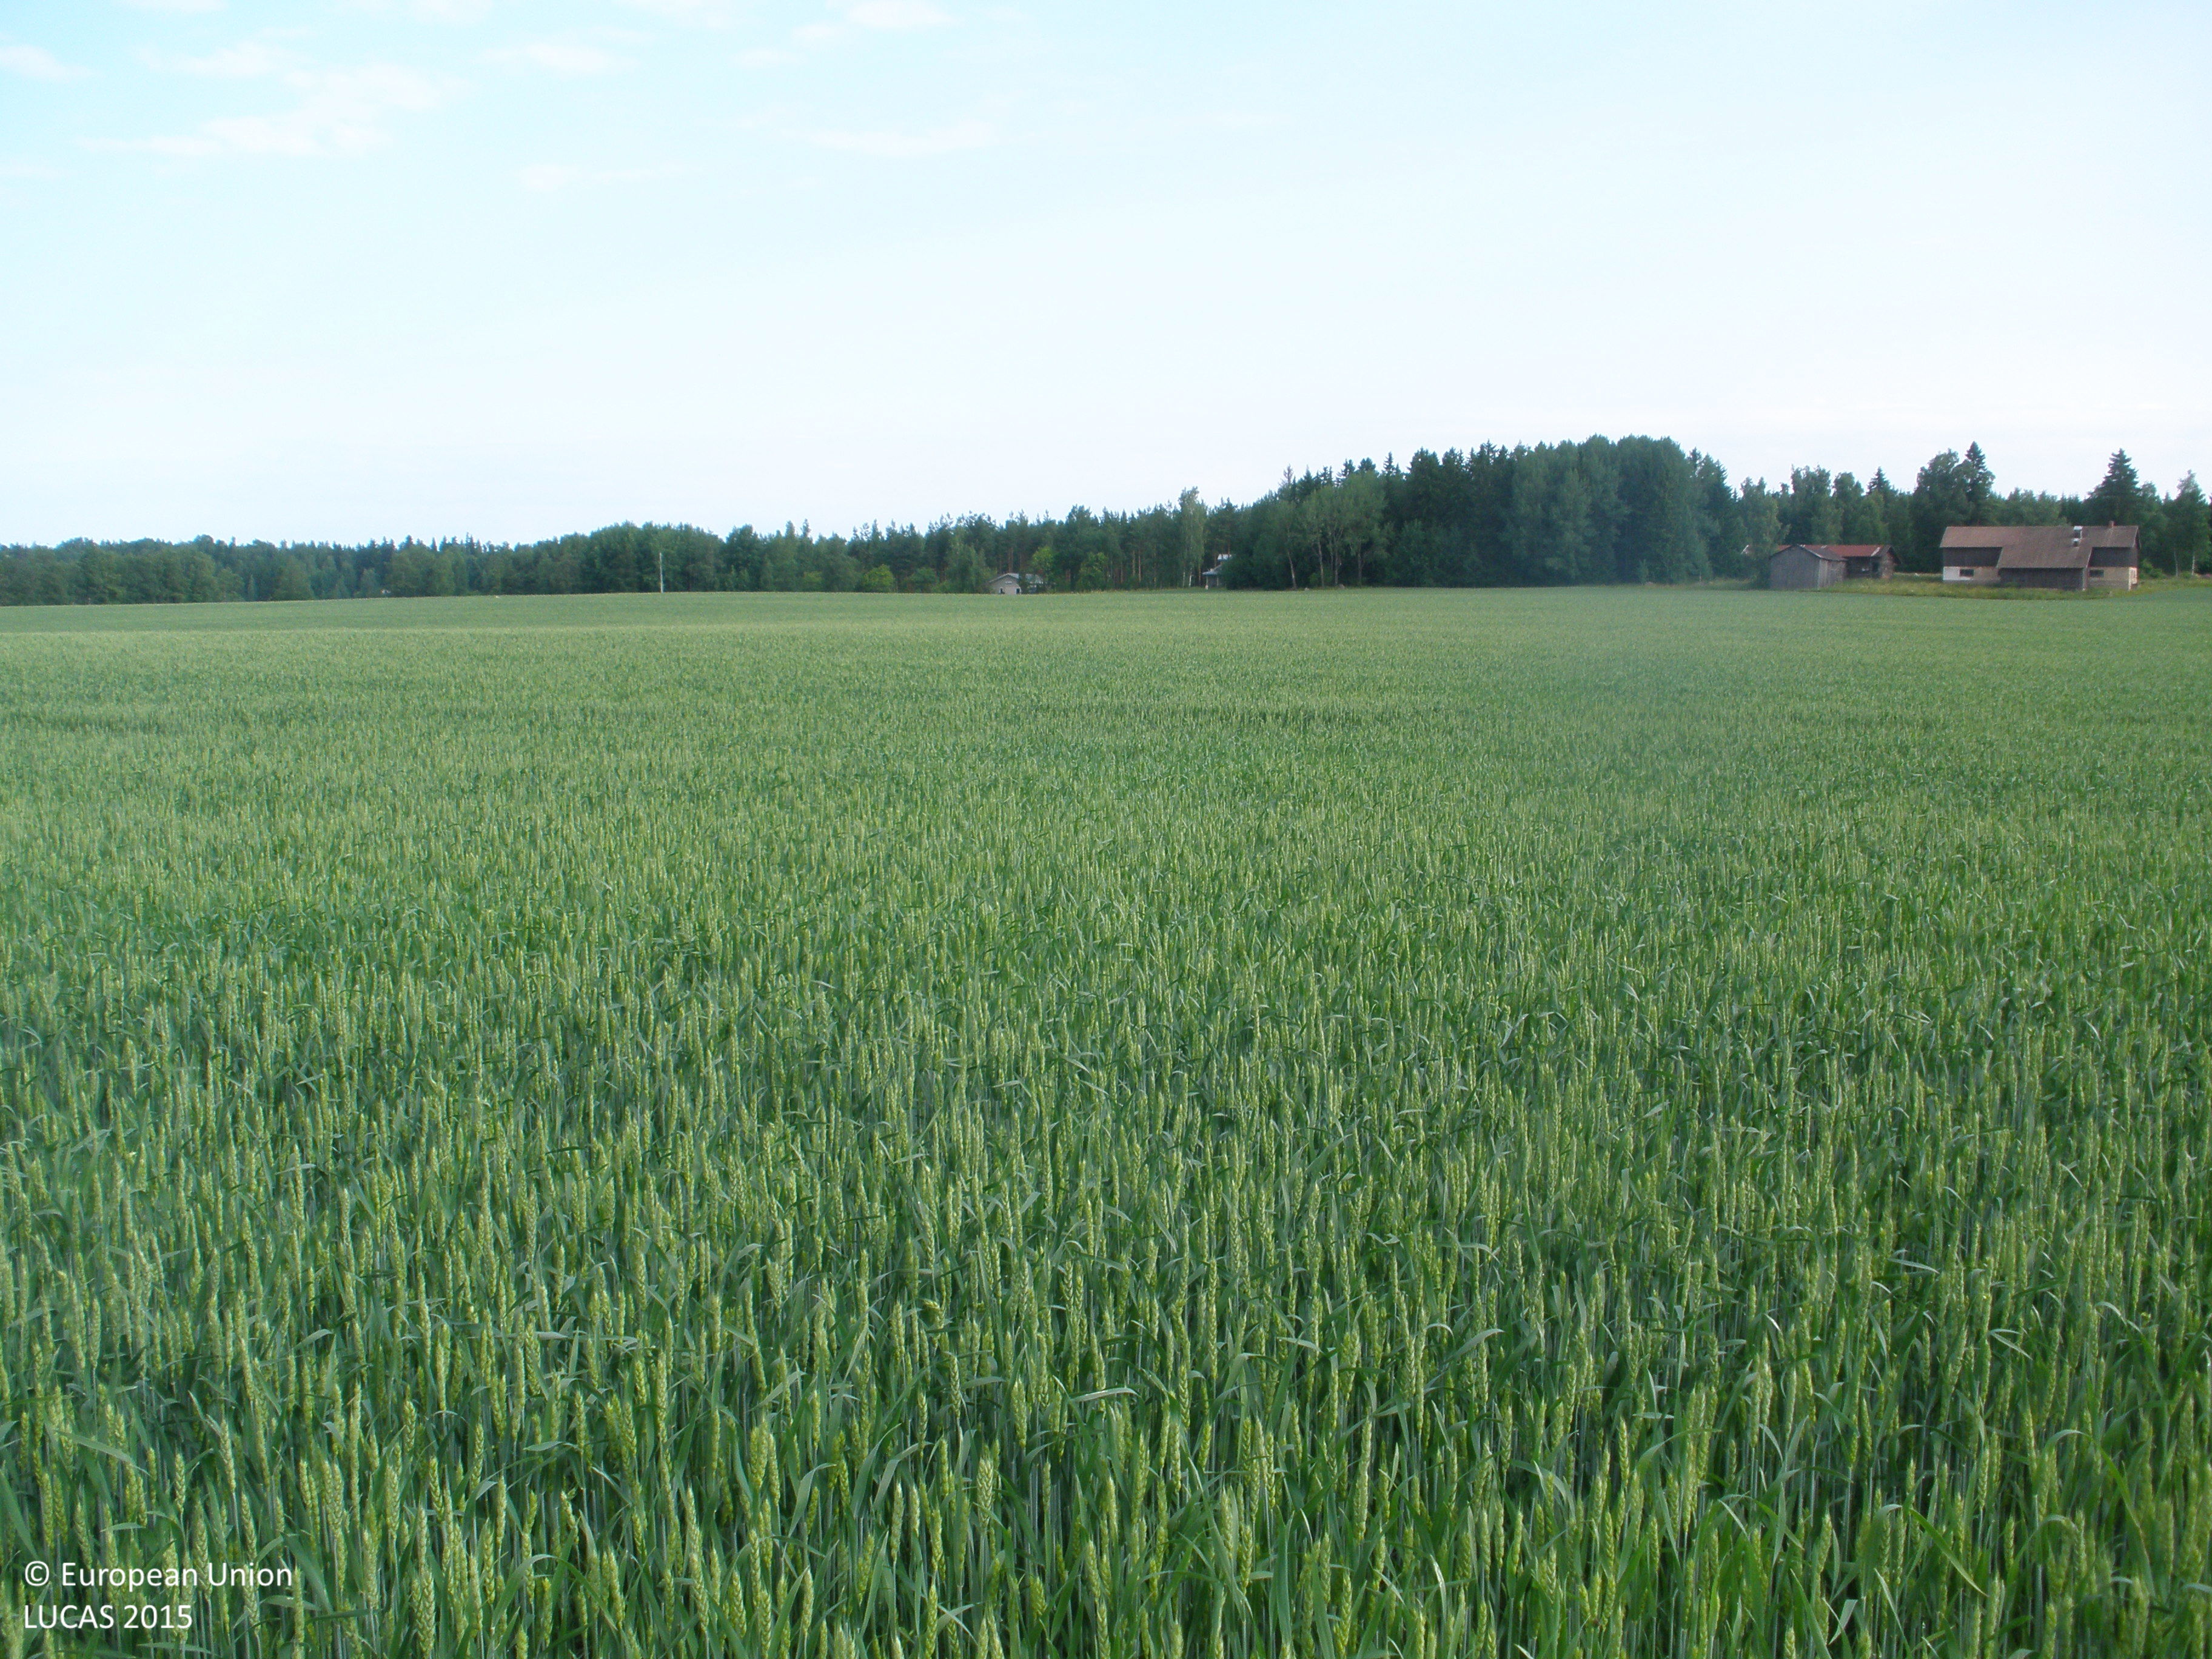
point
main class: Cropland
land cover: Common wheat
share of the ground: 50 - 75 %
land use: Agriculture (excluding fallow land and kitchen gardens)
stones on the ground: < 10 %
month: July
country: FI
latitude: 61.3075
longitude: 23.6579
